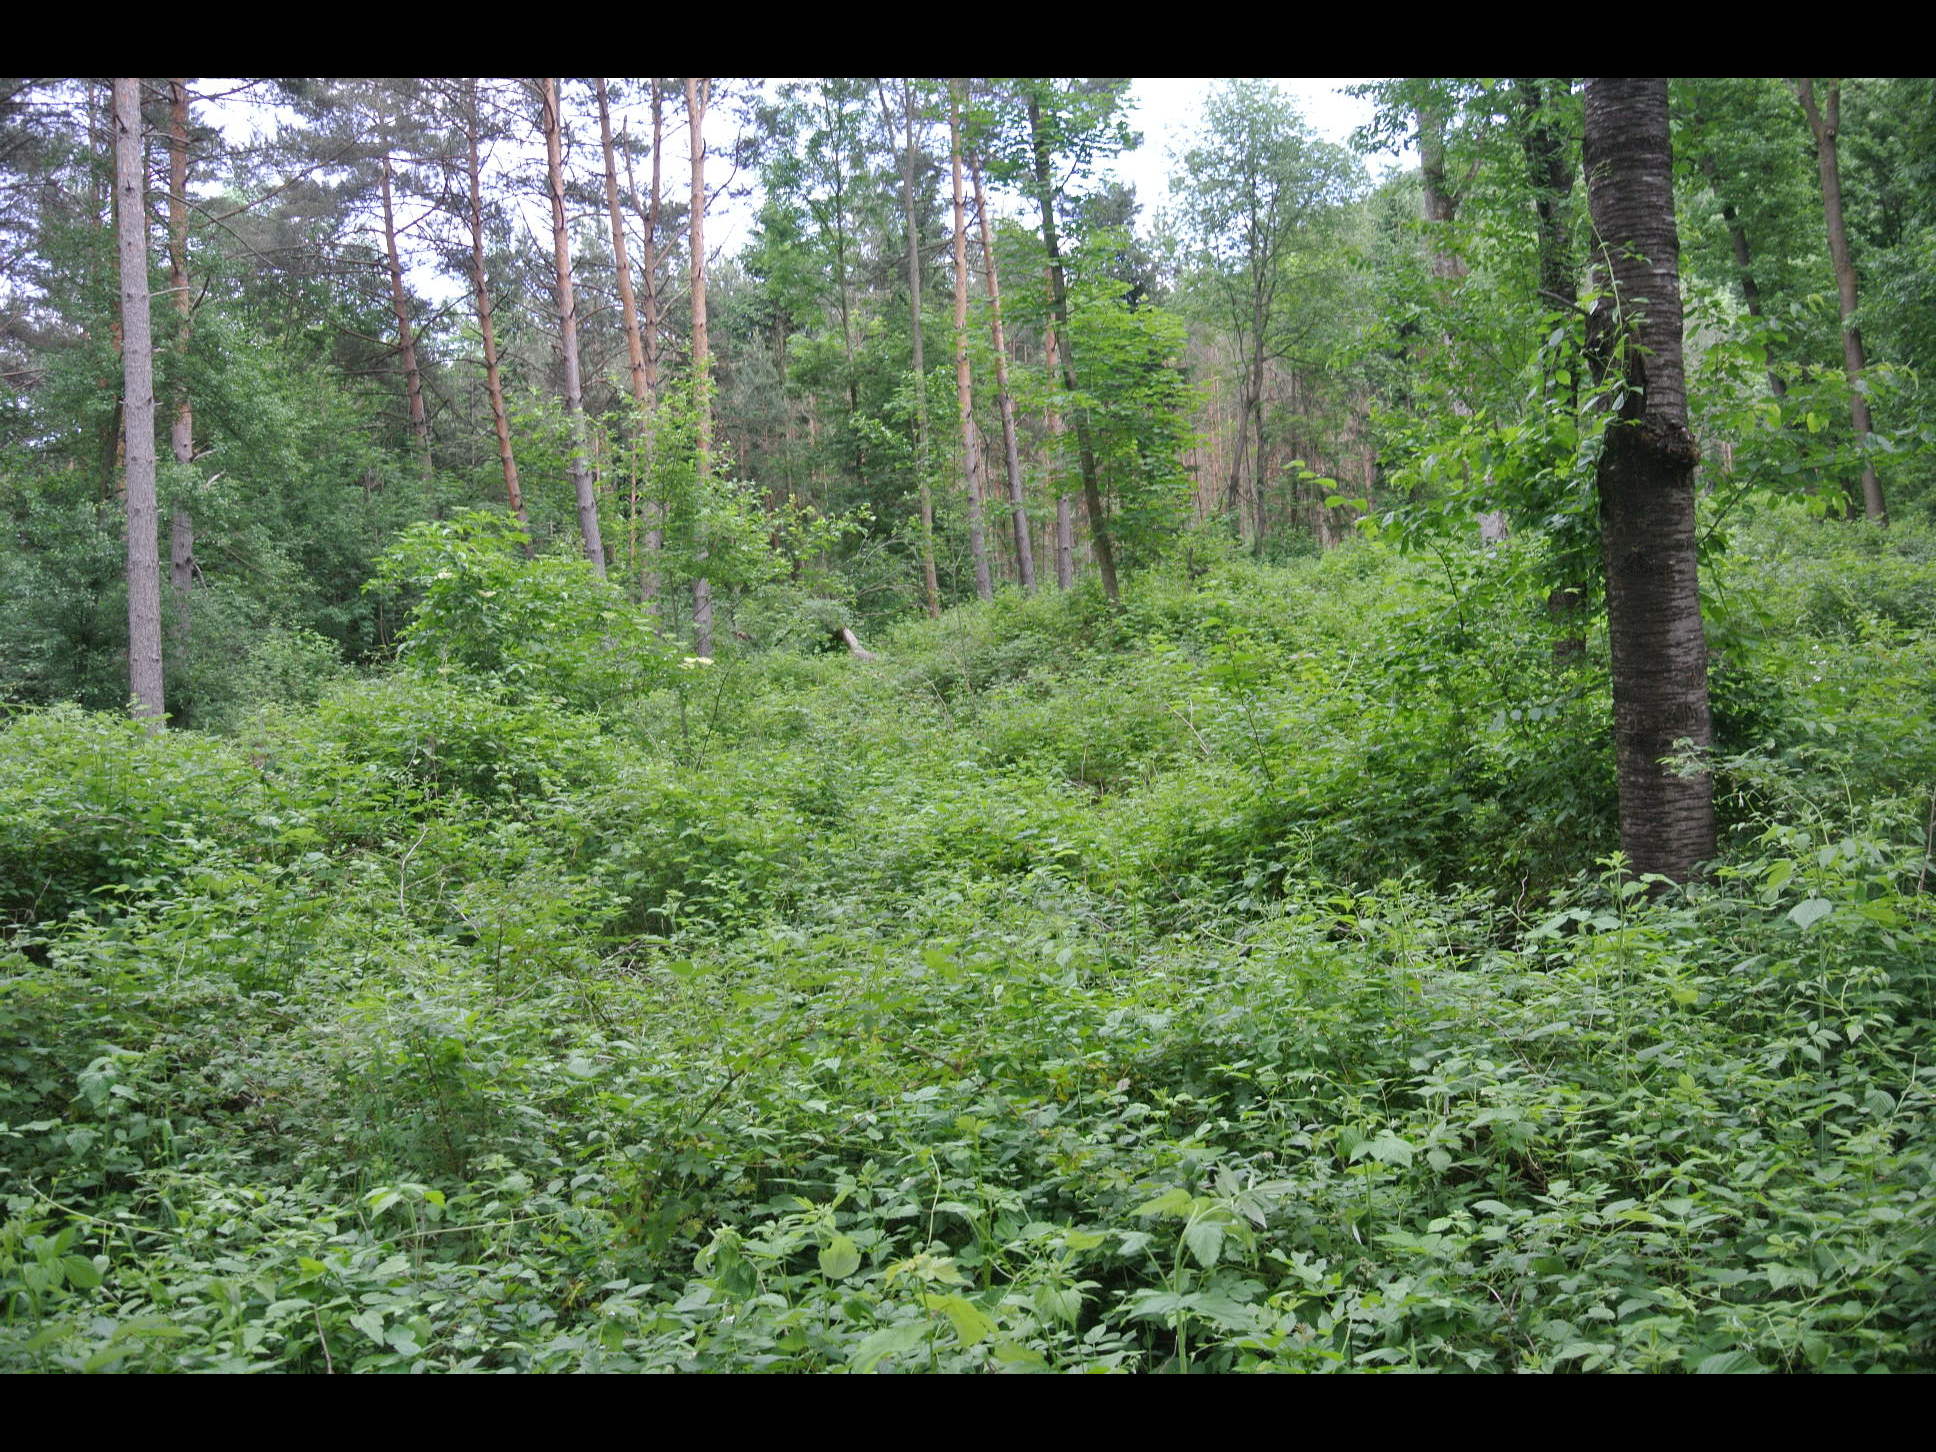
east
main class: Woodland
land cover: Broadleaved woodland
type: beech forest
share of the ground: > 75 %
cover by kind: broadleaved forest trees 80 %, shrubs 10 %, herbaceous plants 10 %
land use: Forestry
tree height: > 5 m
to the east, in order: Broadleaved woodland; Pine dominated coniferous woodland; Pine dominated mixed woodland; Pine dominated coniferous woodland; Tracks; Other coniferous woodland
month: June
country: AT
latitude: 48.0527
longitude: 16.1351
